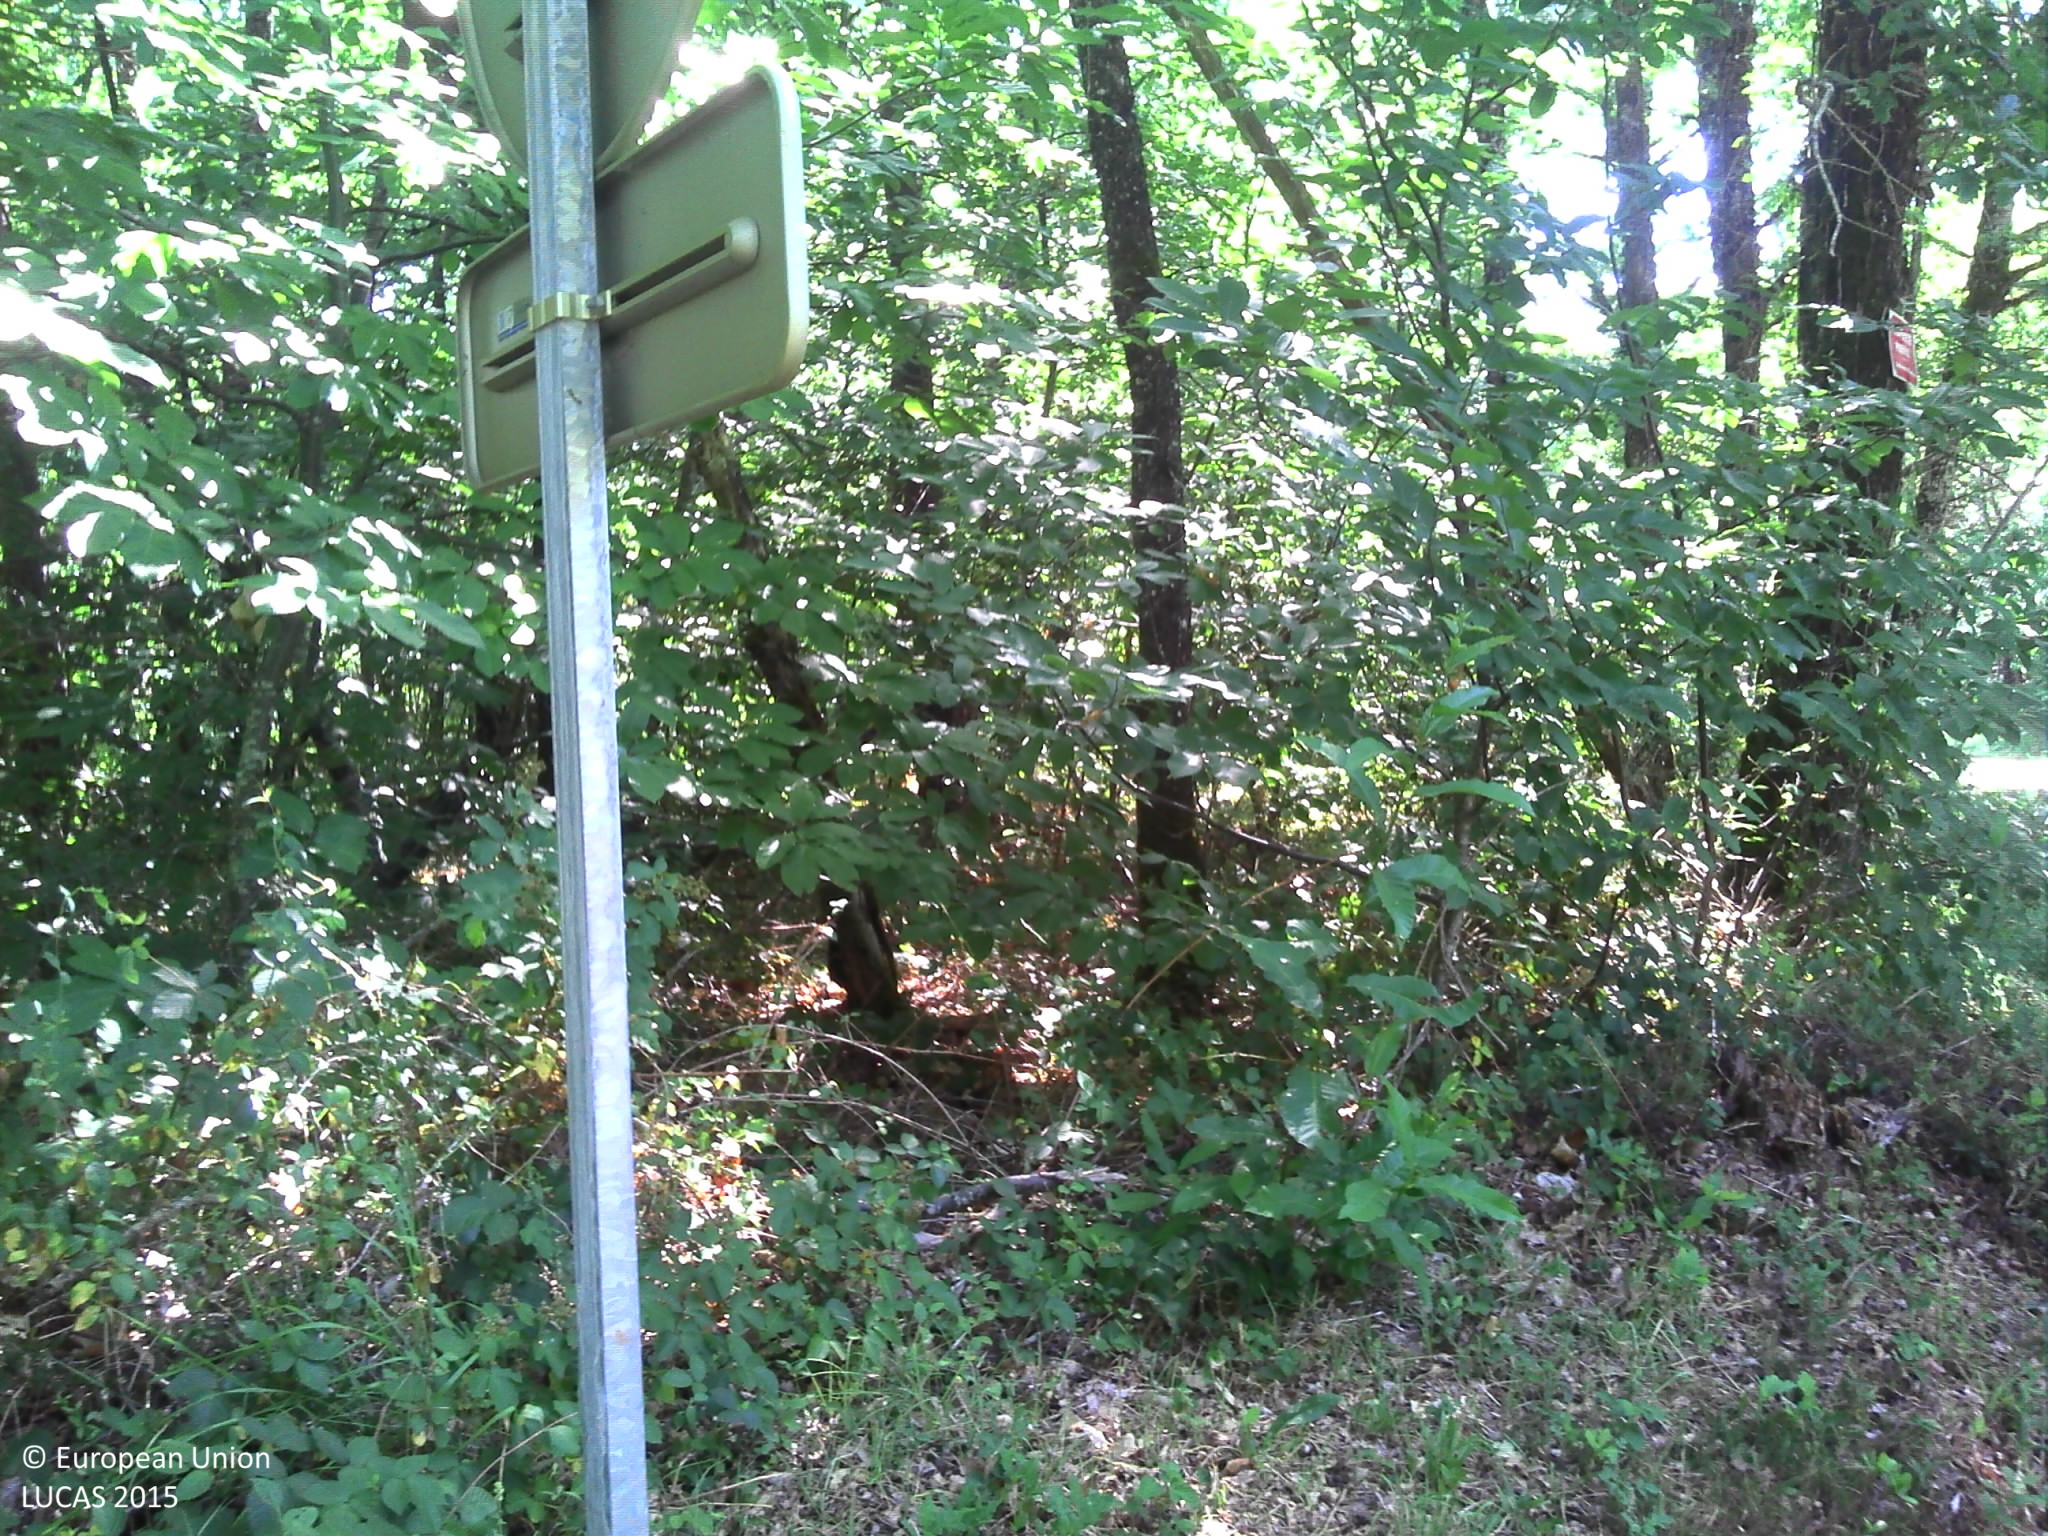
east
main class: Woodland
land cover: Broadleaved woodland
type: acidophilous oak and oak-birch forest
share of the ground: > 75 %
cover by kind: broadleaved forest trees 90 %, shrubs 5 %, herbaceous plants 5 %
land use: Forestry
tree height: > 5 m
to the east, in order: Broadleaved woodland
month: July
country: FR
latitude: 46.5517
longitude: 0.1847
